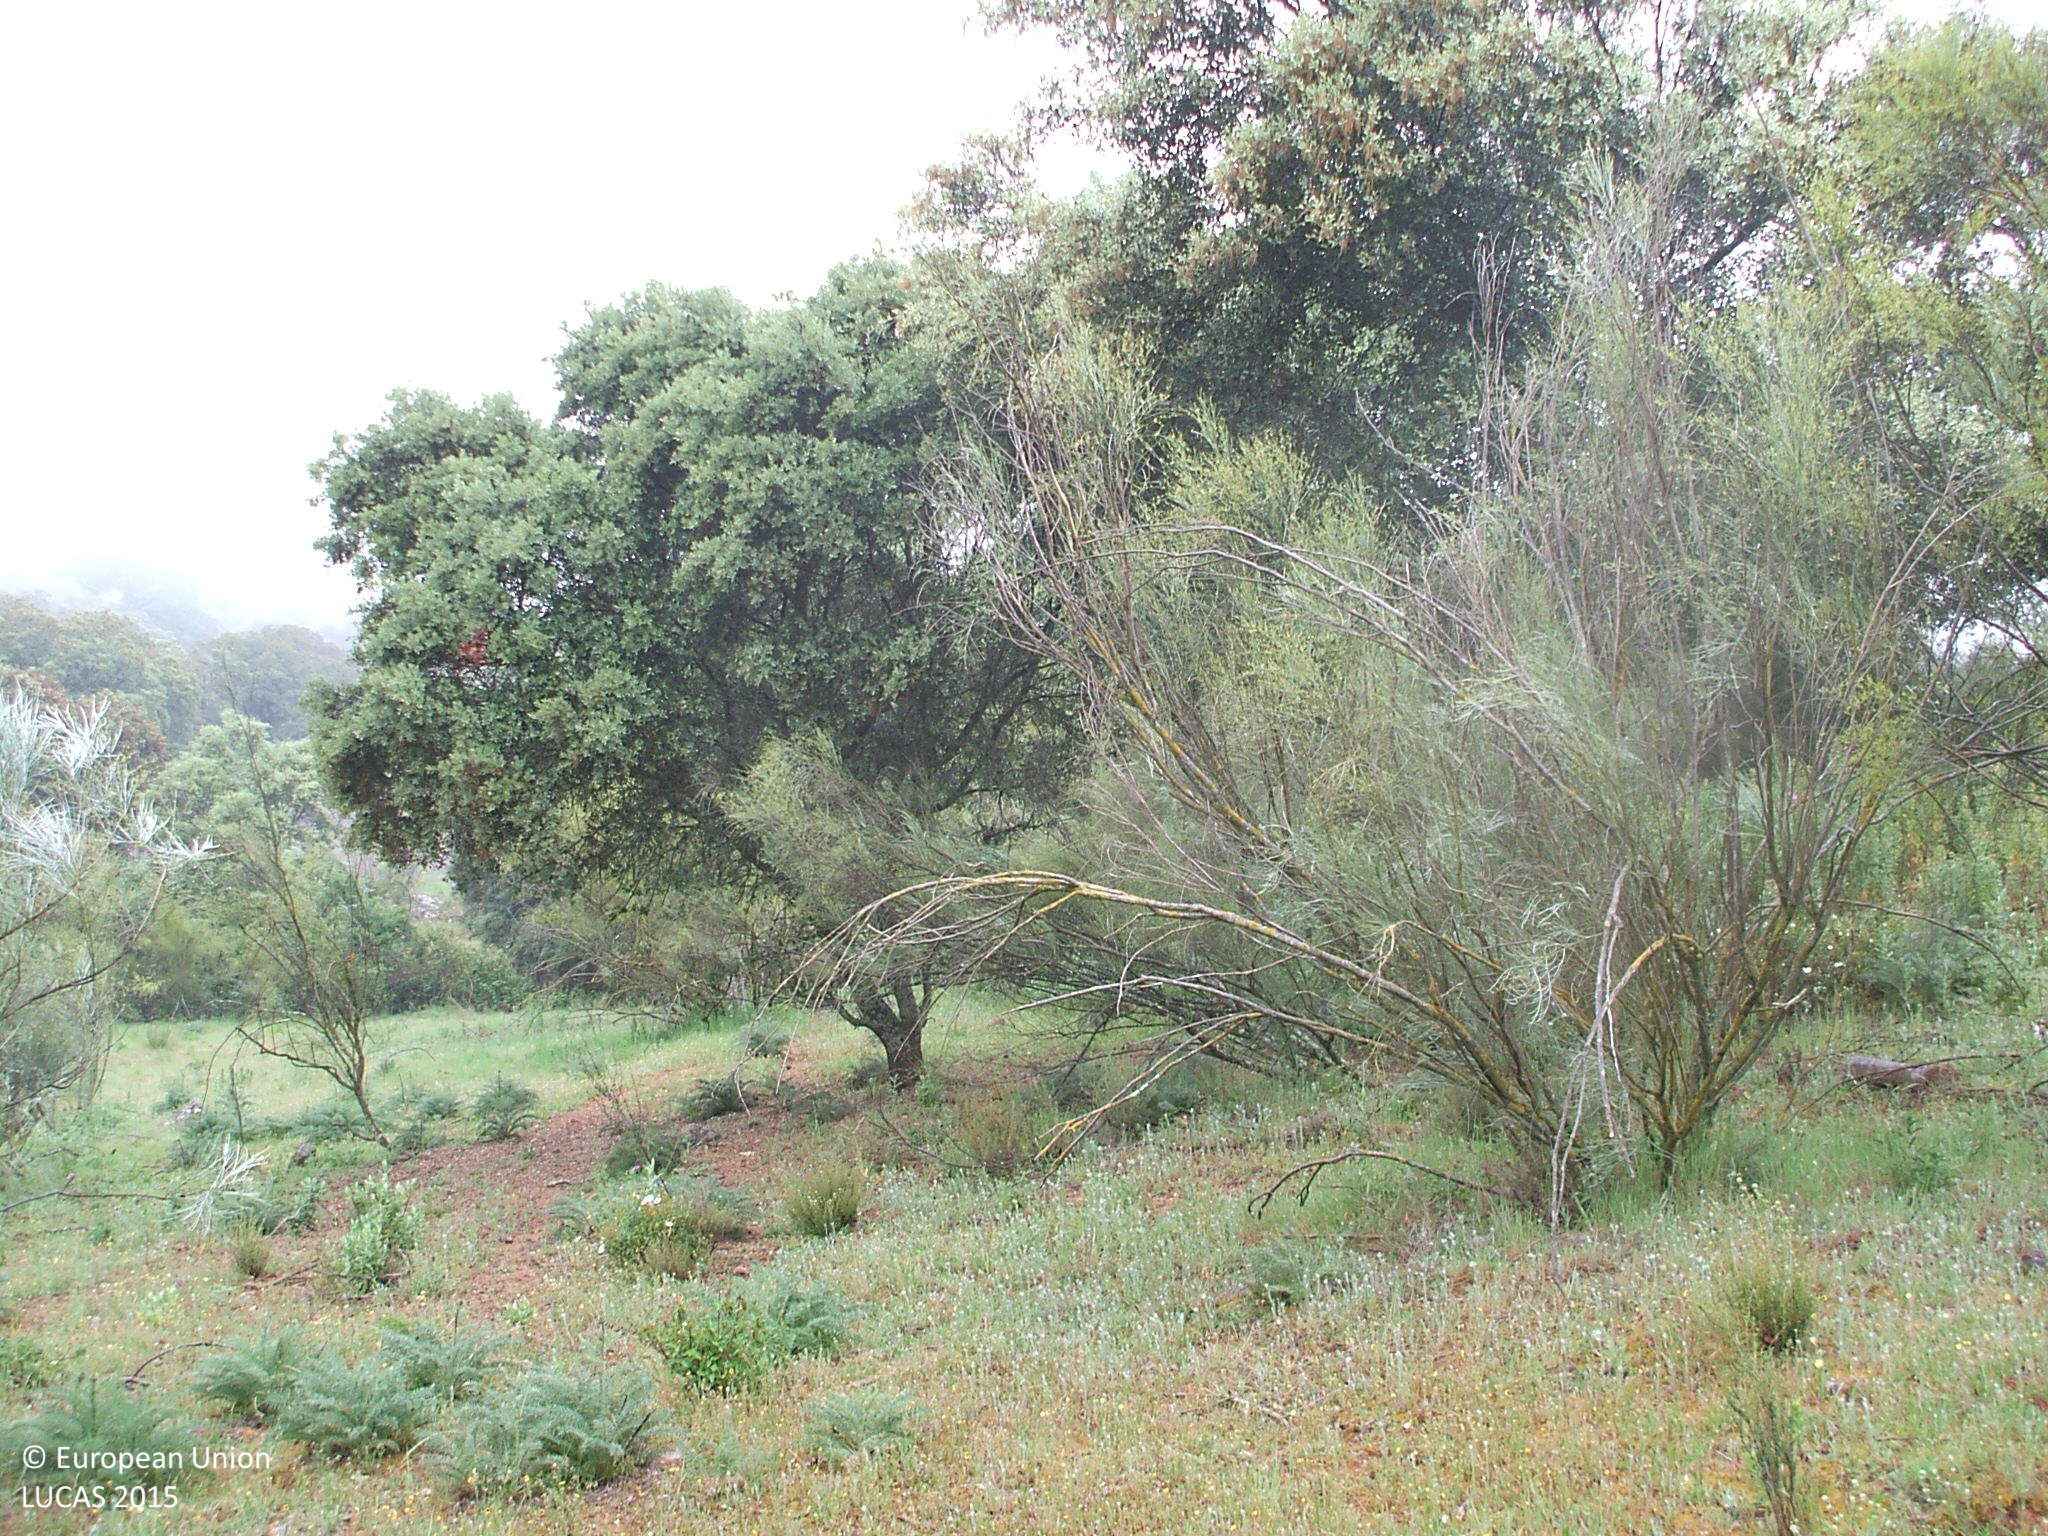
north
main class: Woodland
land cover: Broadleaved woodland
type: broadleaved evergreen forest
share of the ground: 25 - 50 %
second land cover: Shrubland without tree cover
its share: 25 - 50 %
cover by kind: broadleaved forest trees 40 %, shrubs 40 %, herbaceous plants 20 %
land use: Forestry
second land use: Agriculture (excluding fallow land and kitchen gardens)
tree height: > 5 m
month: April
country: ES
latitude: 37.7654
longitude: -5.5644
